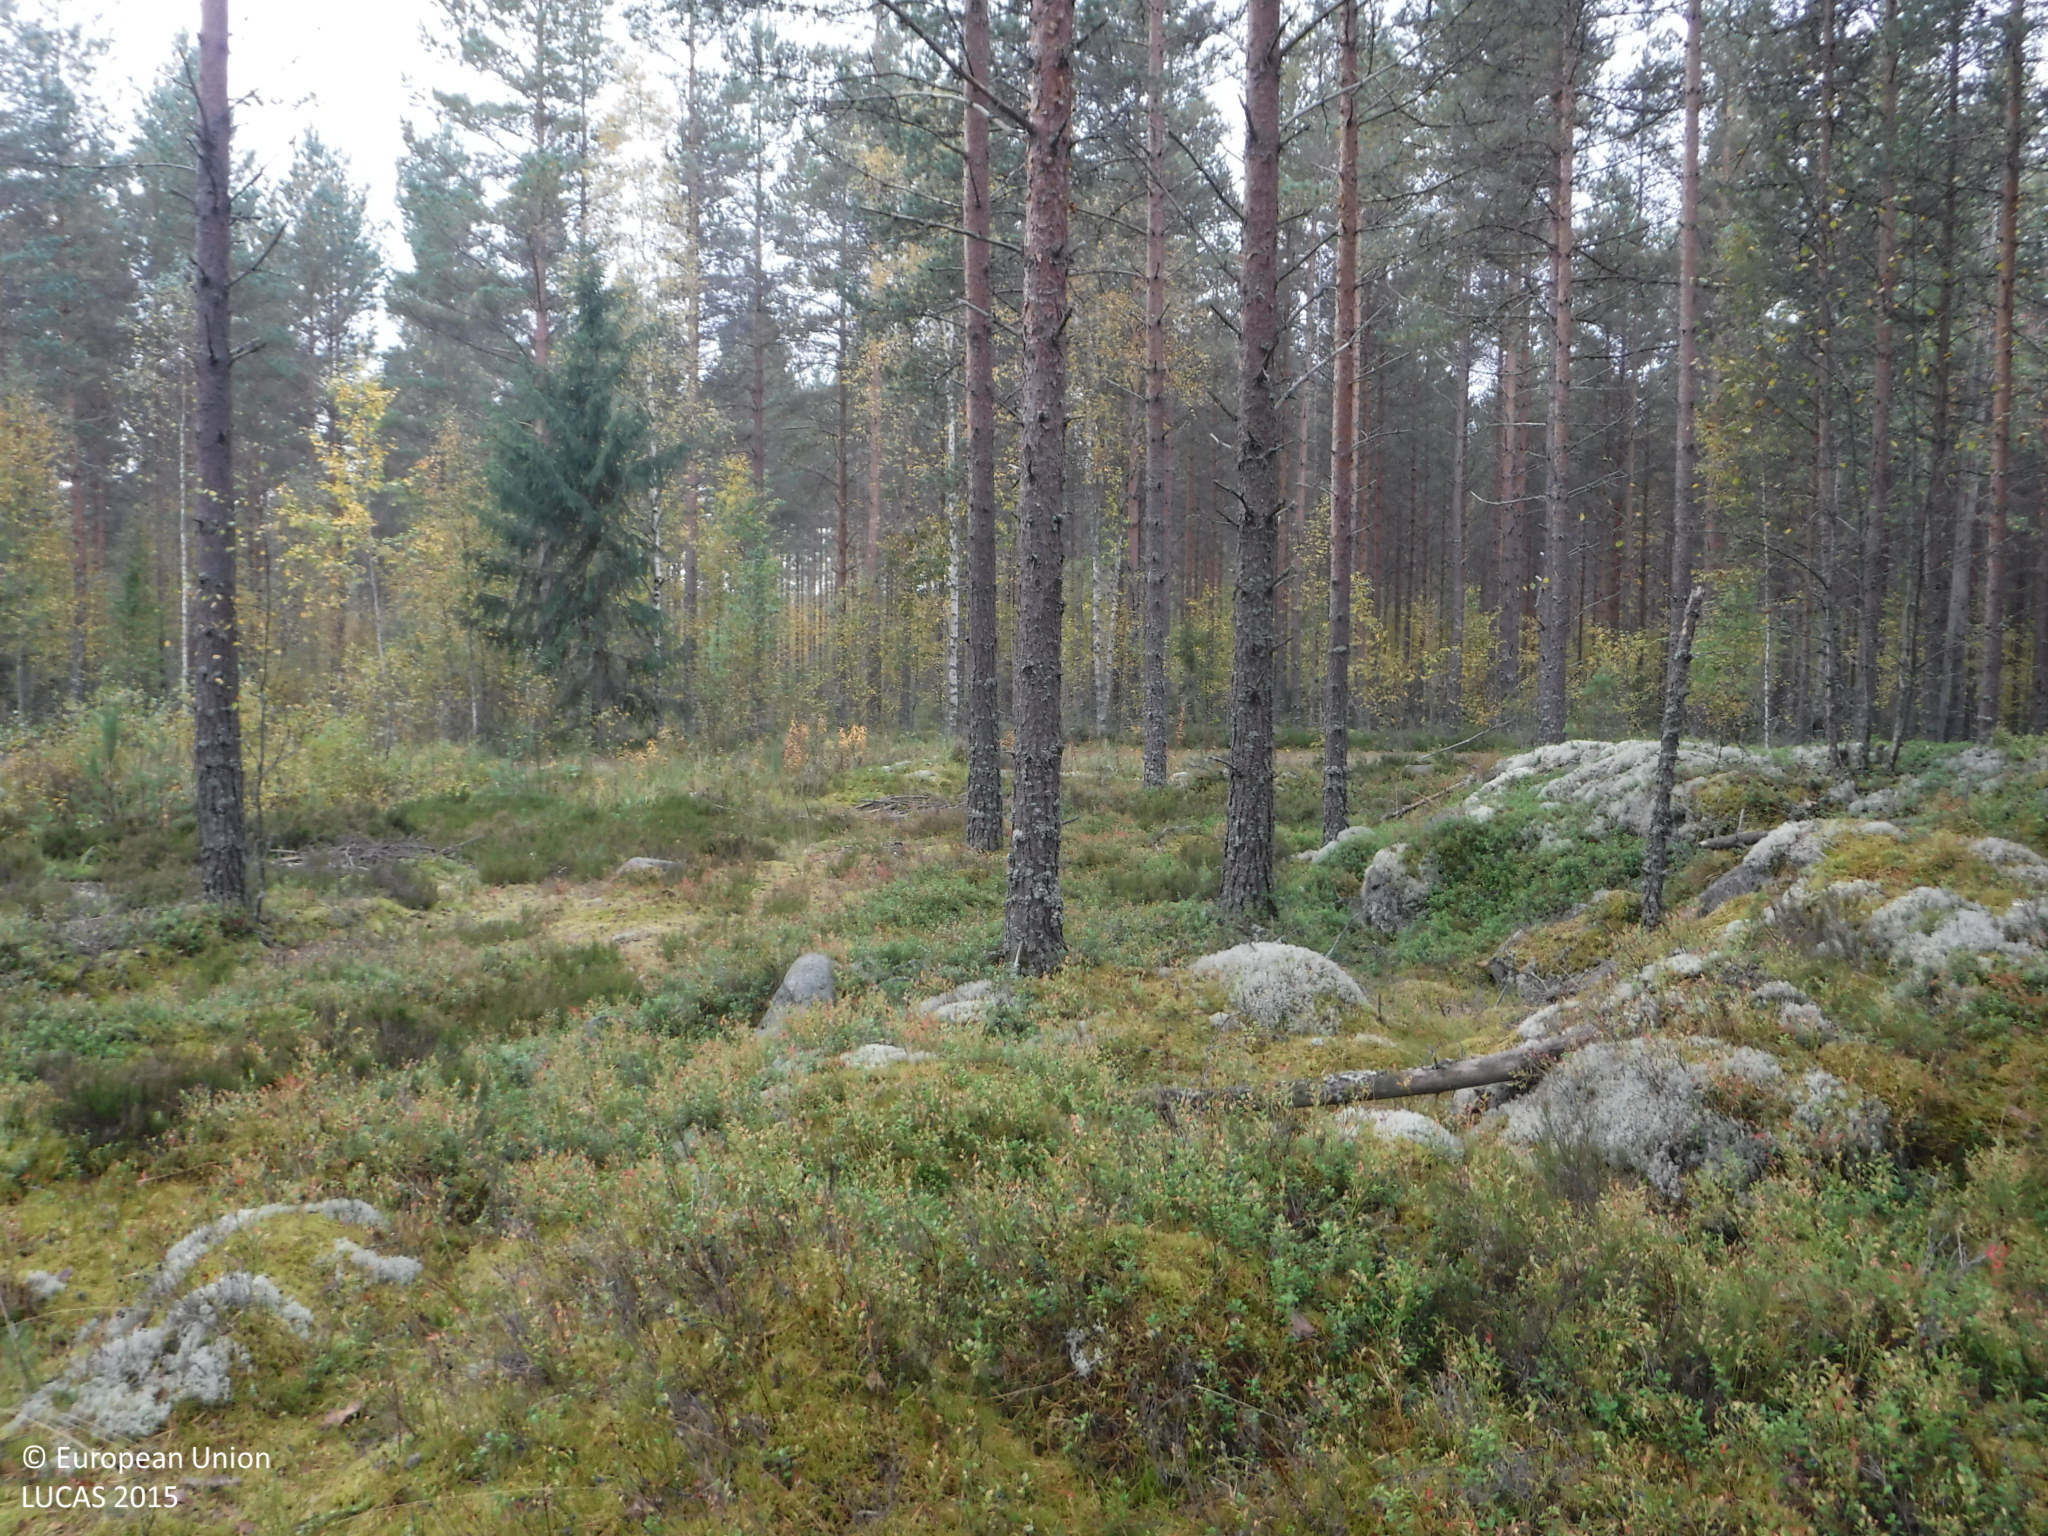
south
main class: Woodland
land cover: Pine dominated coniferous woodland
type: boreal forest
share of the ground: 25 - 50 %
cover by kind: coniferous forest trees 45 %, shrubs 30 %, lichens and mosses 25 %
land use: Forestry
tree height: > 5 m
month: September
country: FI
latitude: 61.9435
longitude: 22.2735
